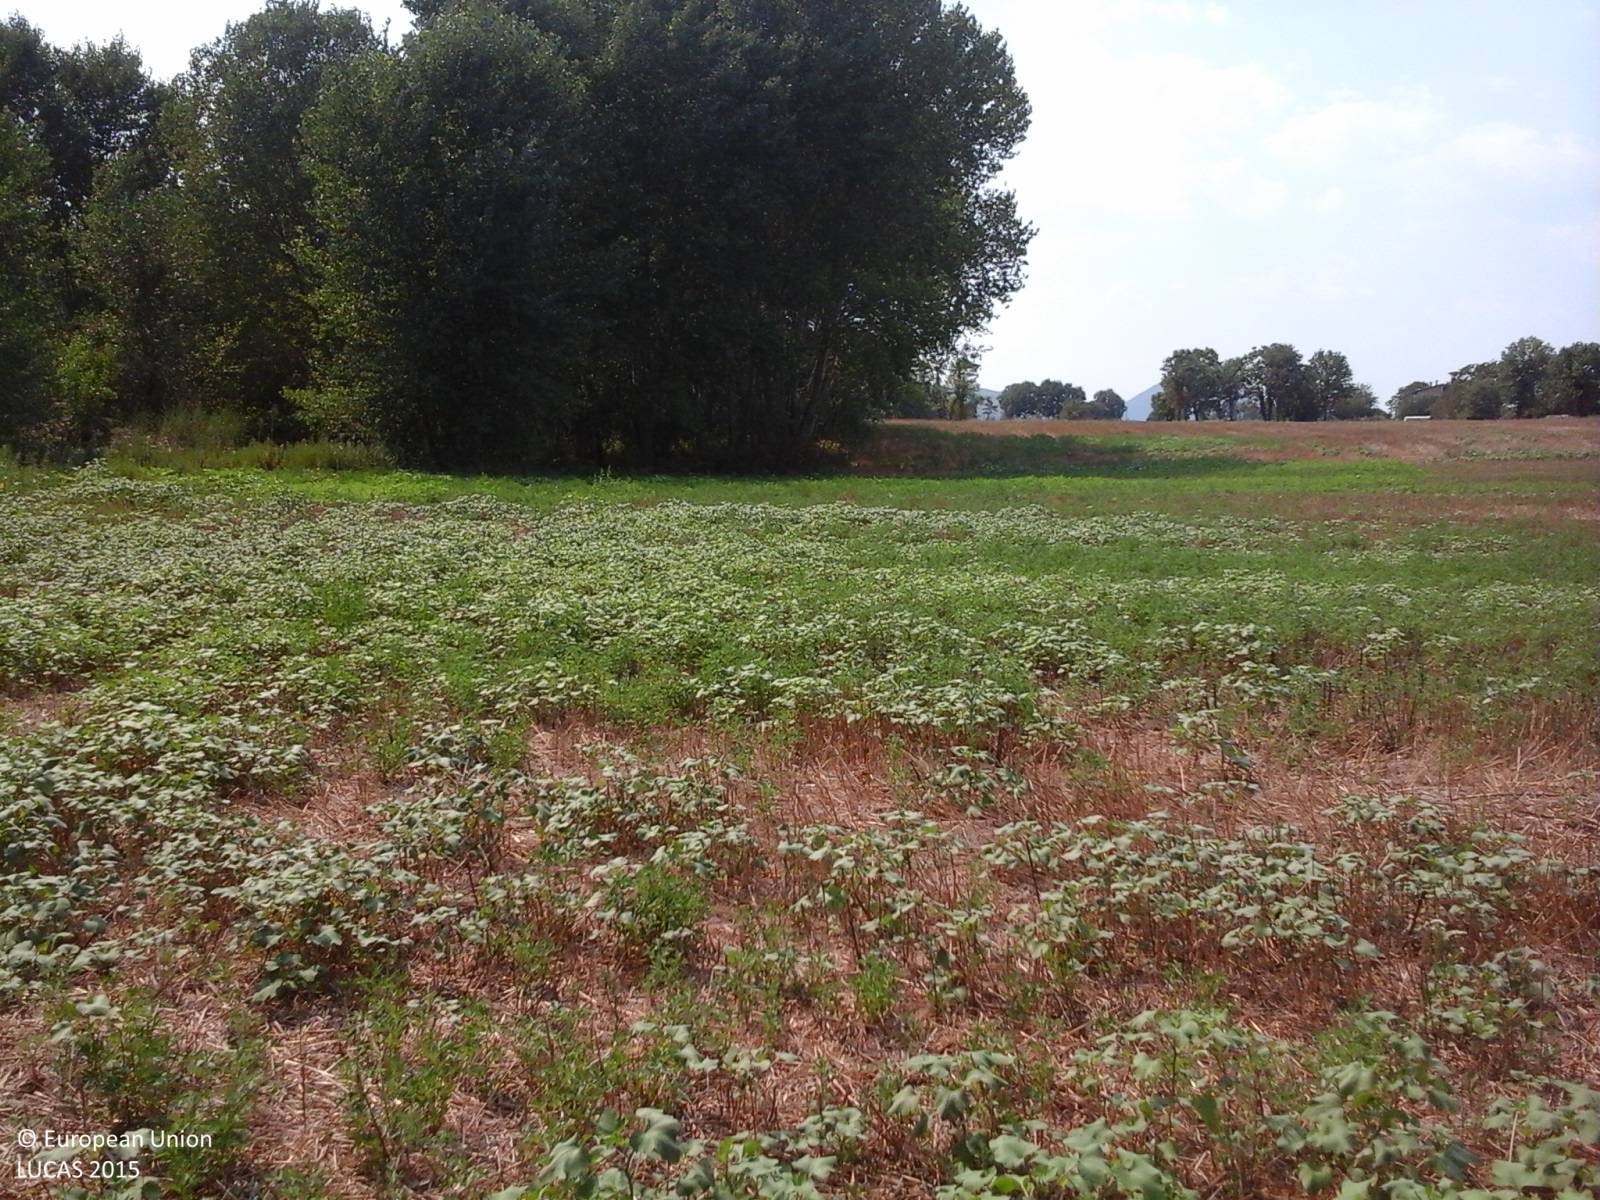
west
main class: Woodland
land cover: Broadleaved woodland
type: thermophilous deciduous forest
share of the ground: > 75 %
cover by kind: broadleaved forest trees 90 %, shrubs 10 %
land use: Semi-natural and natural areas not in use
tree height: > 5 m
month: August
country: IT
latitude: 41.4295
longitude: 13.6834
